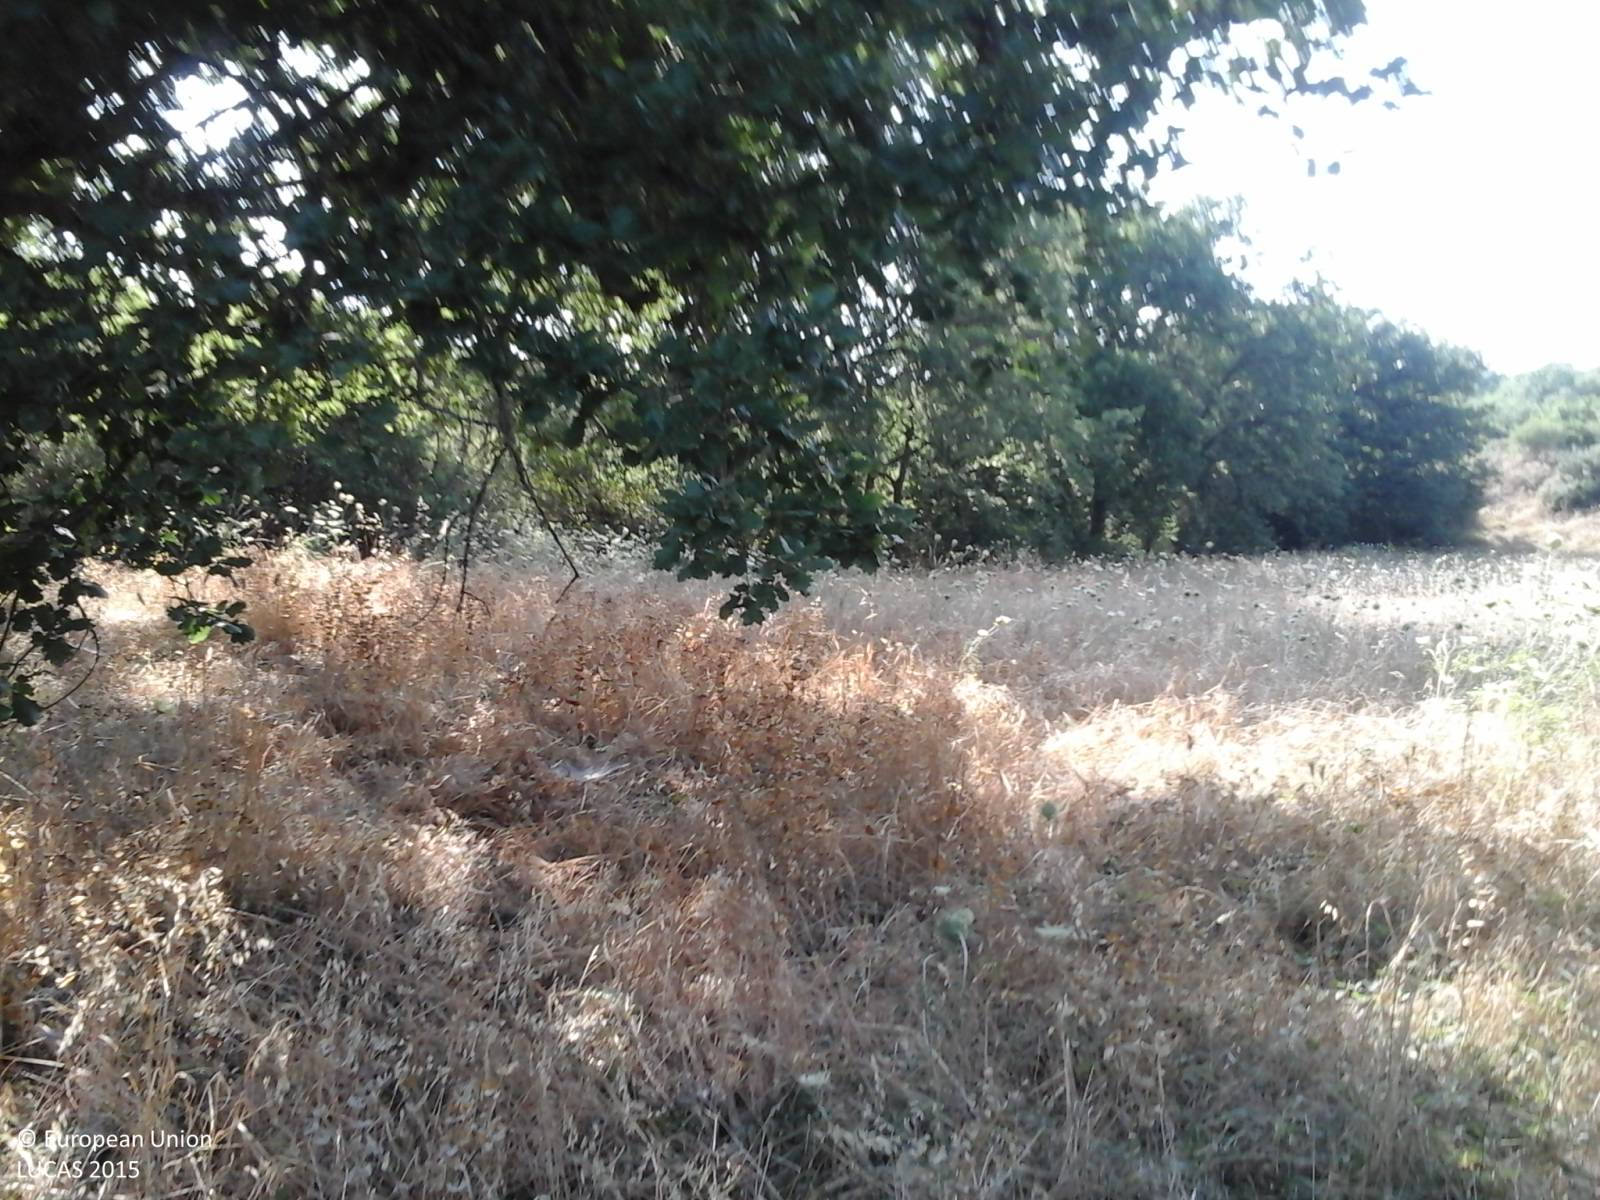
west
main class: Woodland
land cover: Broadleaved woodland
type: broadleaved evergreen forest
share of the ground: 25 - 50 %
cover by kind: broadleaved forest trees 50 %, herbaceous plants 50 %
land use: Agriculture (excluding fallow land and kitchen gardens)
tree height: < 5 m
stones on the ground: < 10 %
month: July
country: IT
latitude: 40.0254
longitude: 8.8696
